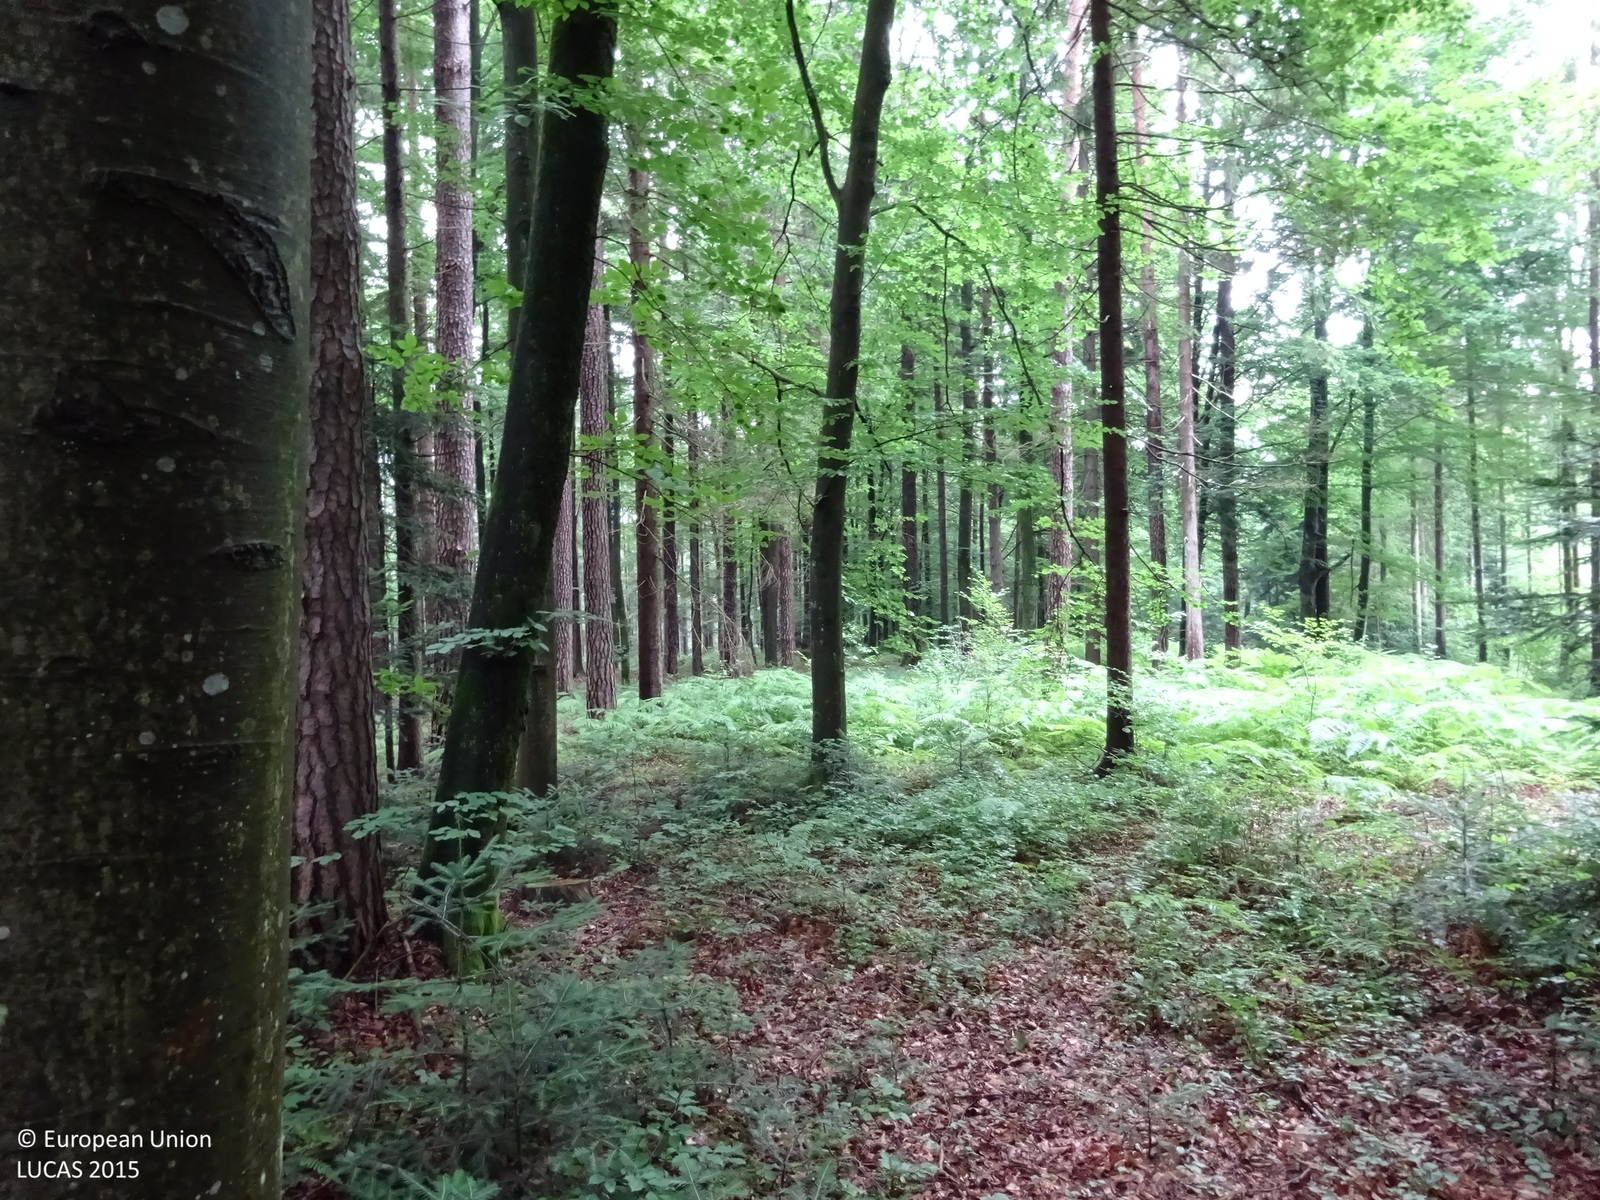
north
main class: Woodland
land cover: Pine dominated mixed woodland
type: mountainous beech forest
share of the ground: > 75 %
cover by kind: broadleaved forest trees 70 %, coniferous forest trees 30 %
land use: Forestry
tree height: > 5 m
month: June
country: AT
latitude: 46.7099
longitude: 15.2440
